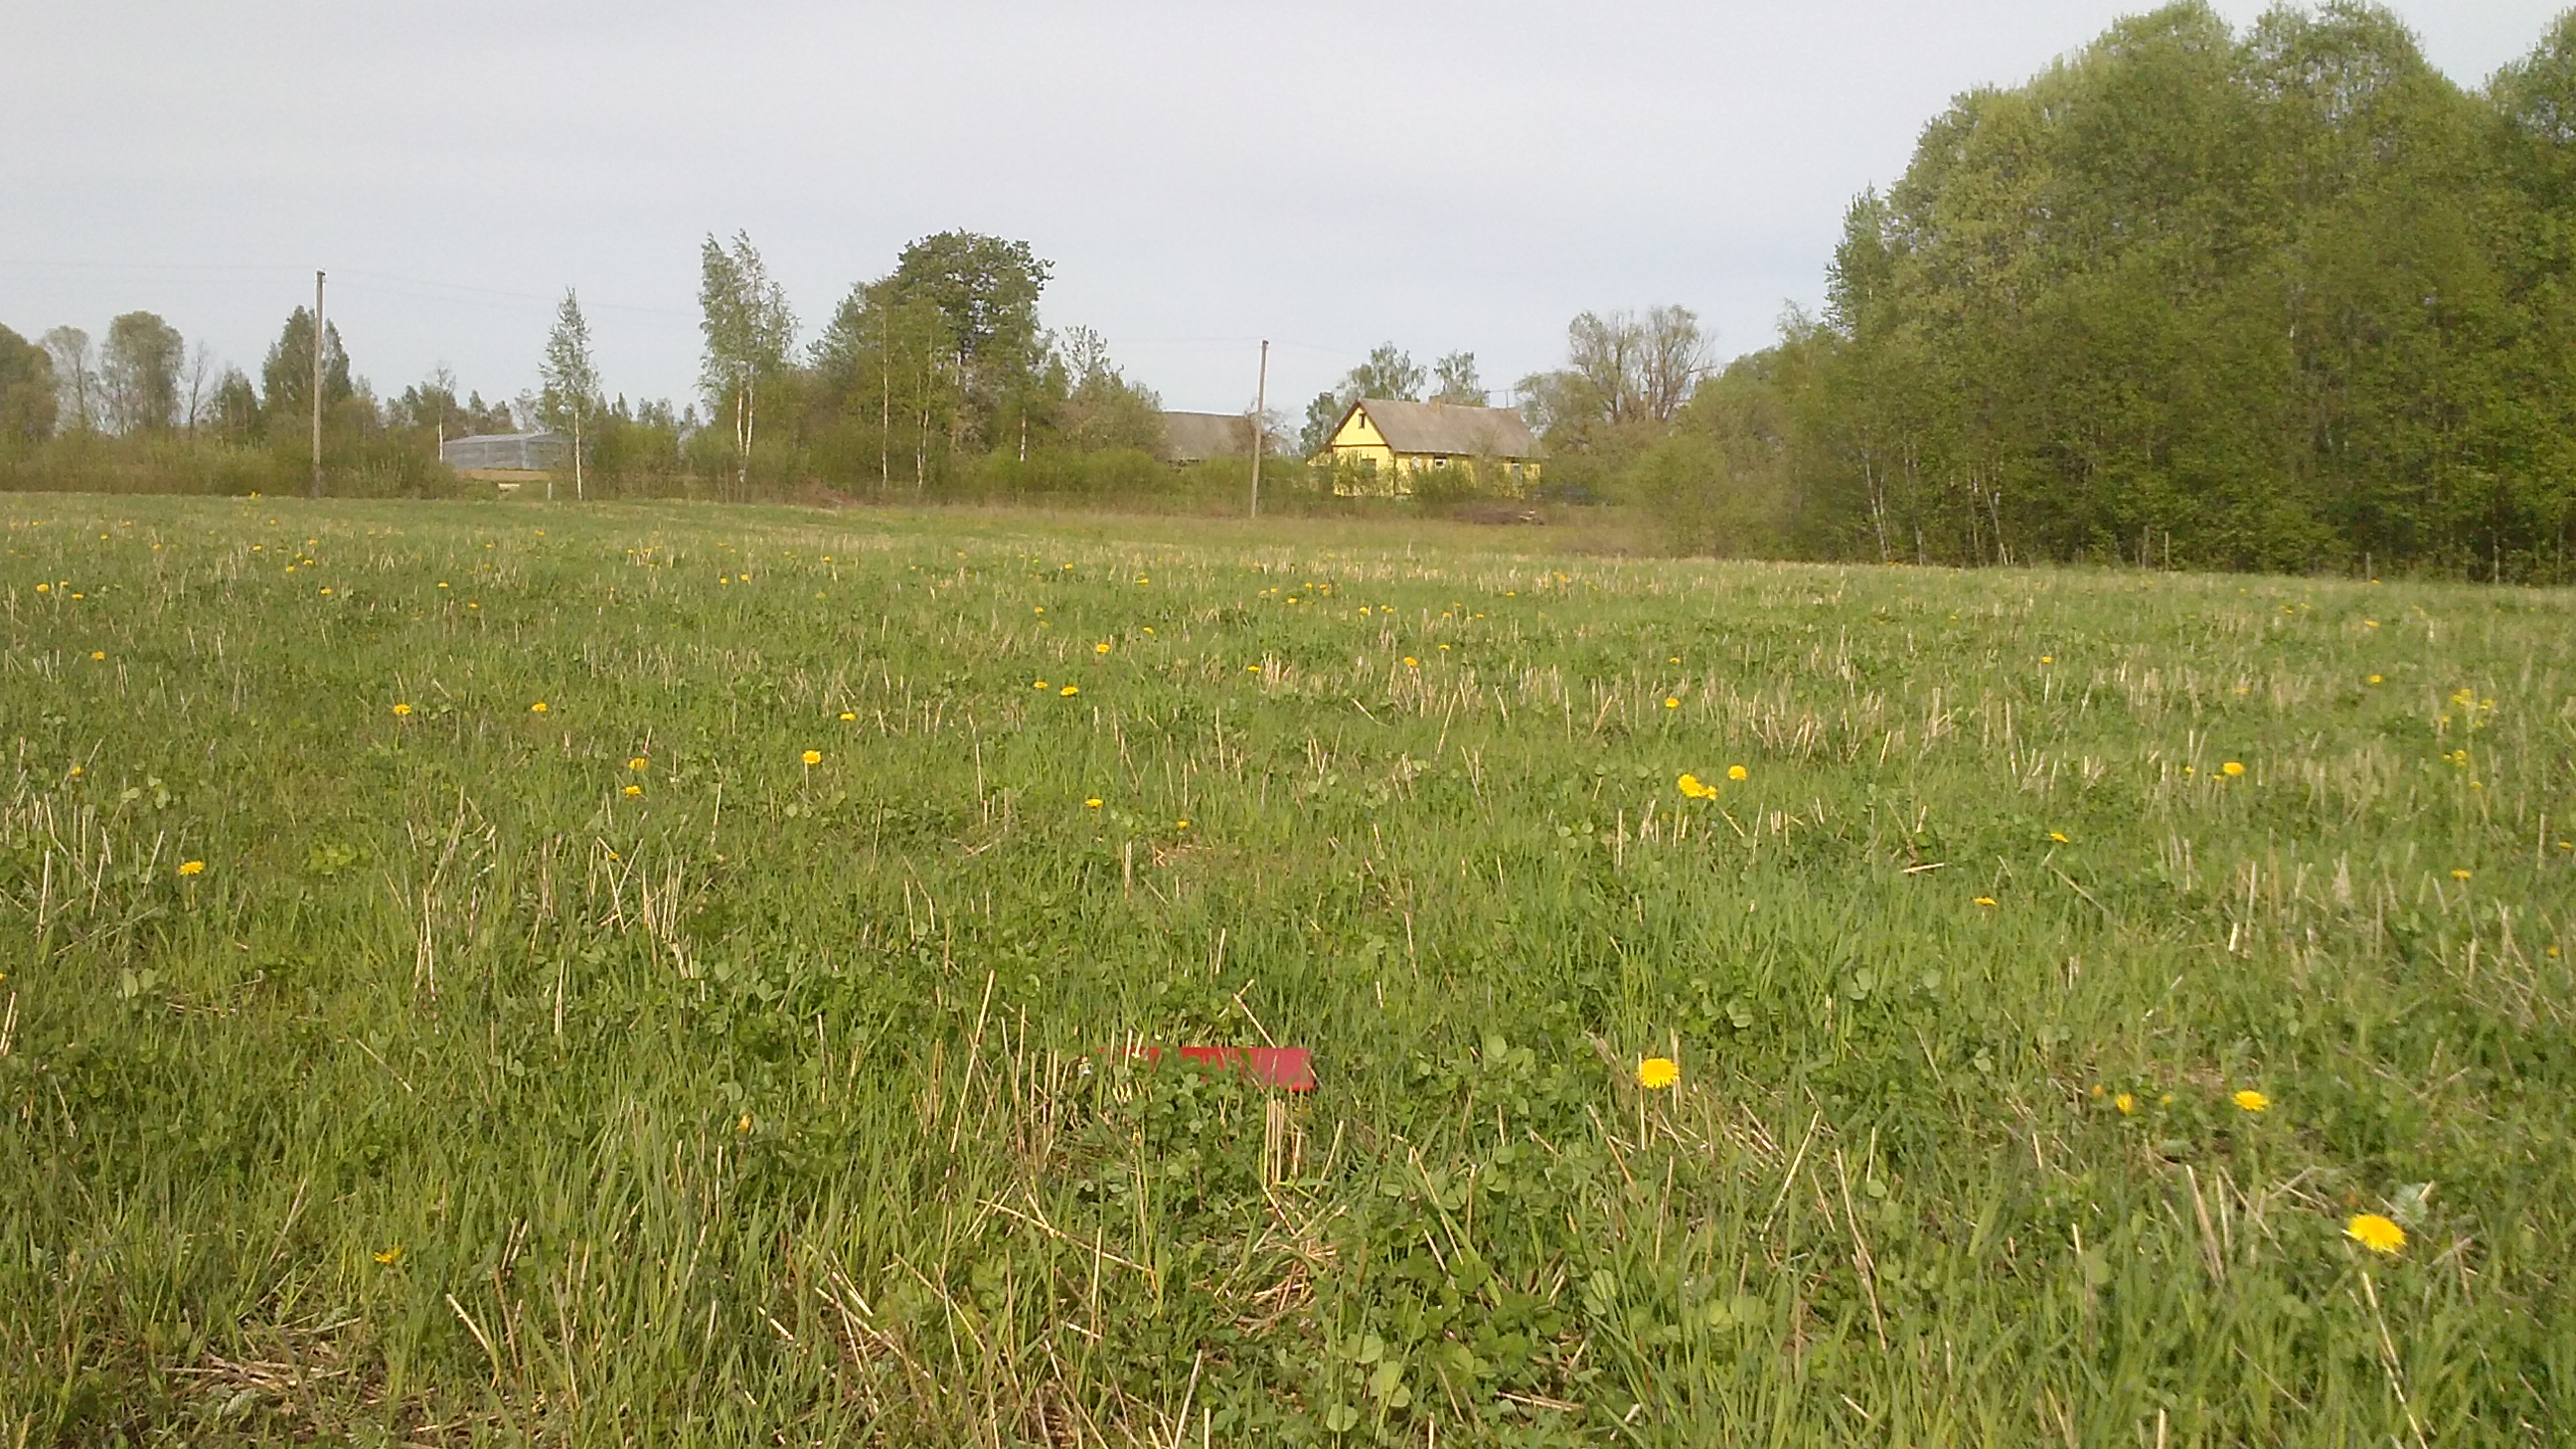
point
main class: Grassland
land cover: Grassland without tree/shrub cover
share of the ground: > 75 %
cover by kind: herbaceous plants 100 %
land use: Agriculture (excluding fallow land and kitchen gardens)
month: May
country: LV
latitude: 56.0103
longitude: 27.5868
